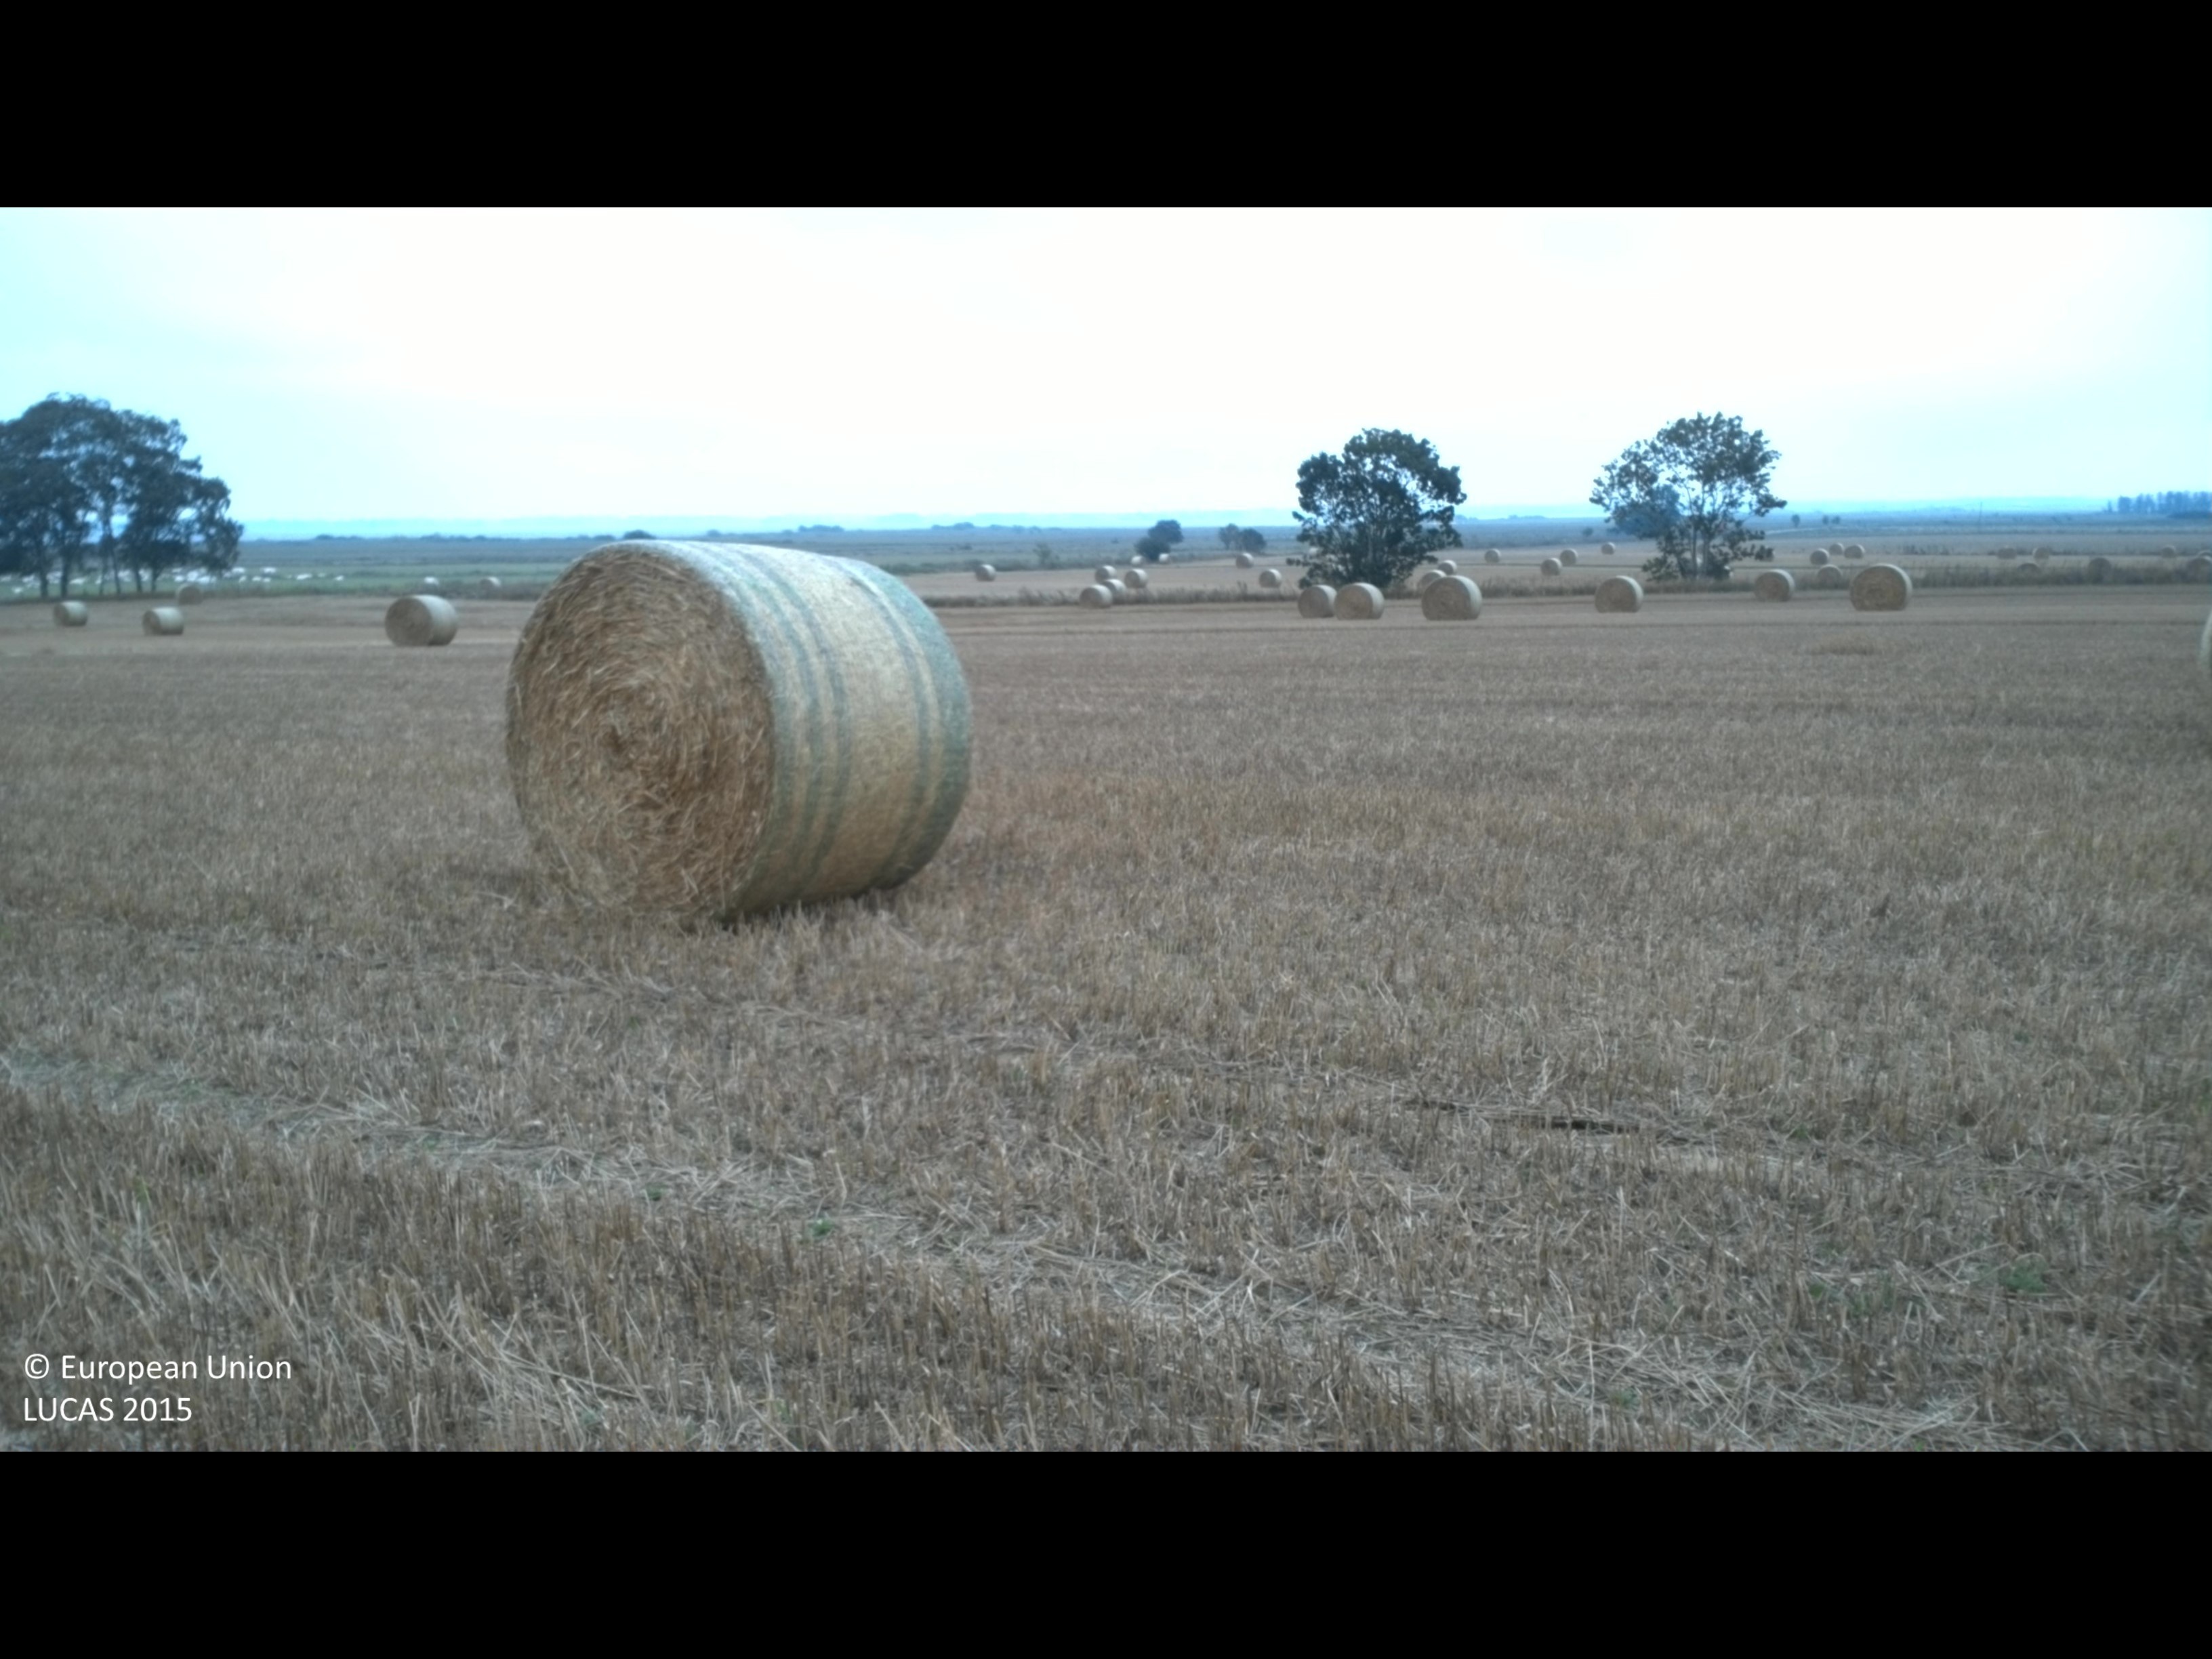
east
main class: Cropland
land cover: Common wheat
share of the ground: > 75 %
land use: Agriculture (excluding fallow land and kitchen gardens)
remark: Harvested field
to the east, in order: Common wheat; Grass margins; Dry stone walls; Grass margins; Common wheat; Grassland without tree/shrub cover; Shruby margins; Dry stone walls; Fences; Grassland without tree/shrub cover
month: September
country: SE
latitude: 55.9757
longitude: 14.1805
